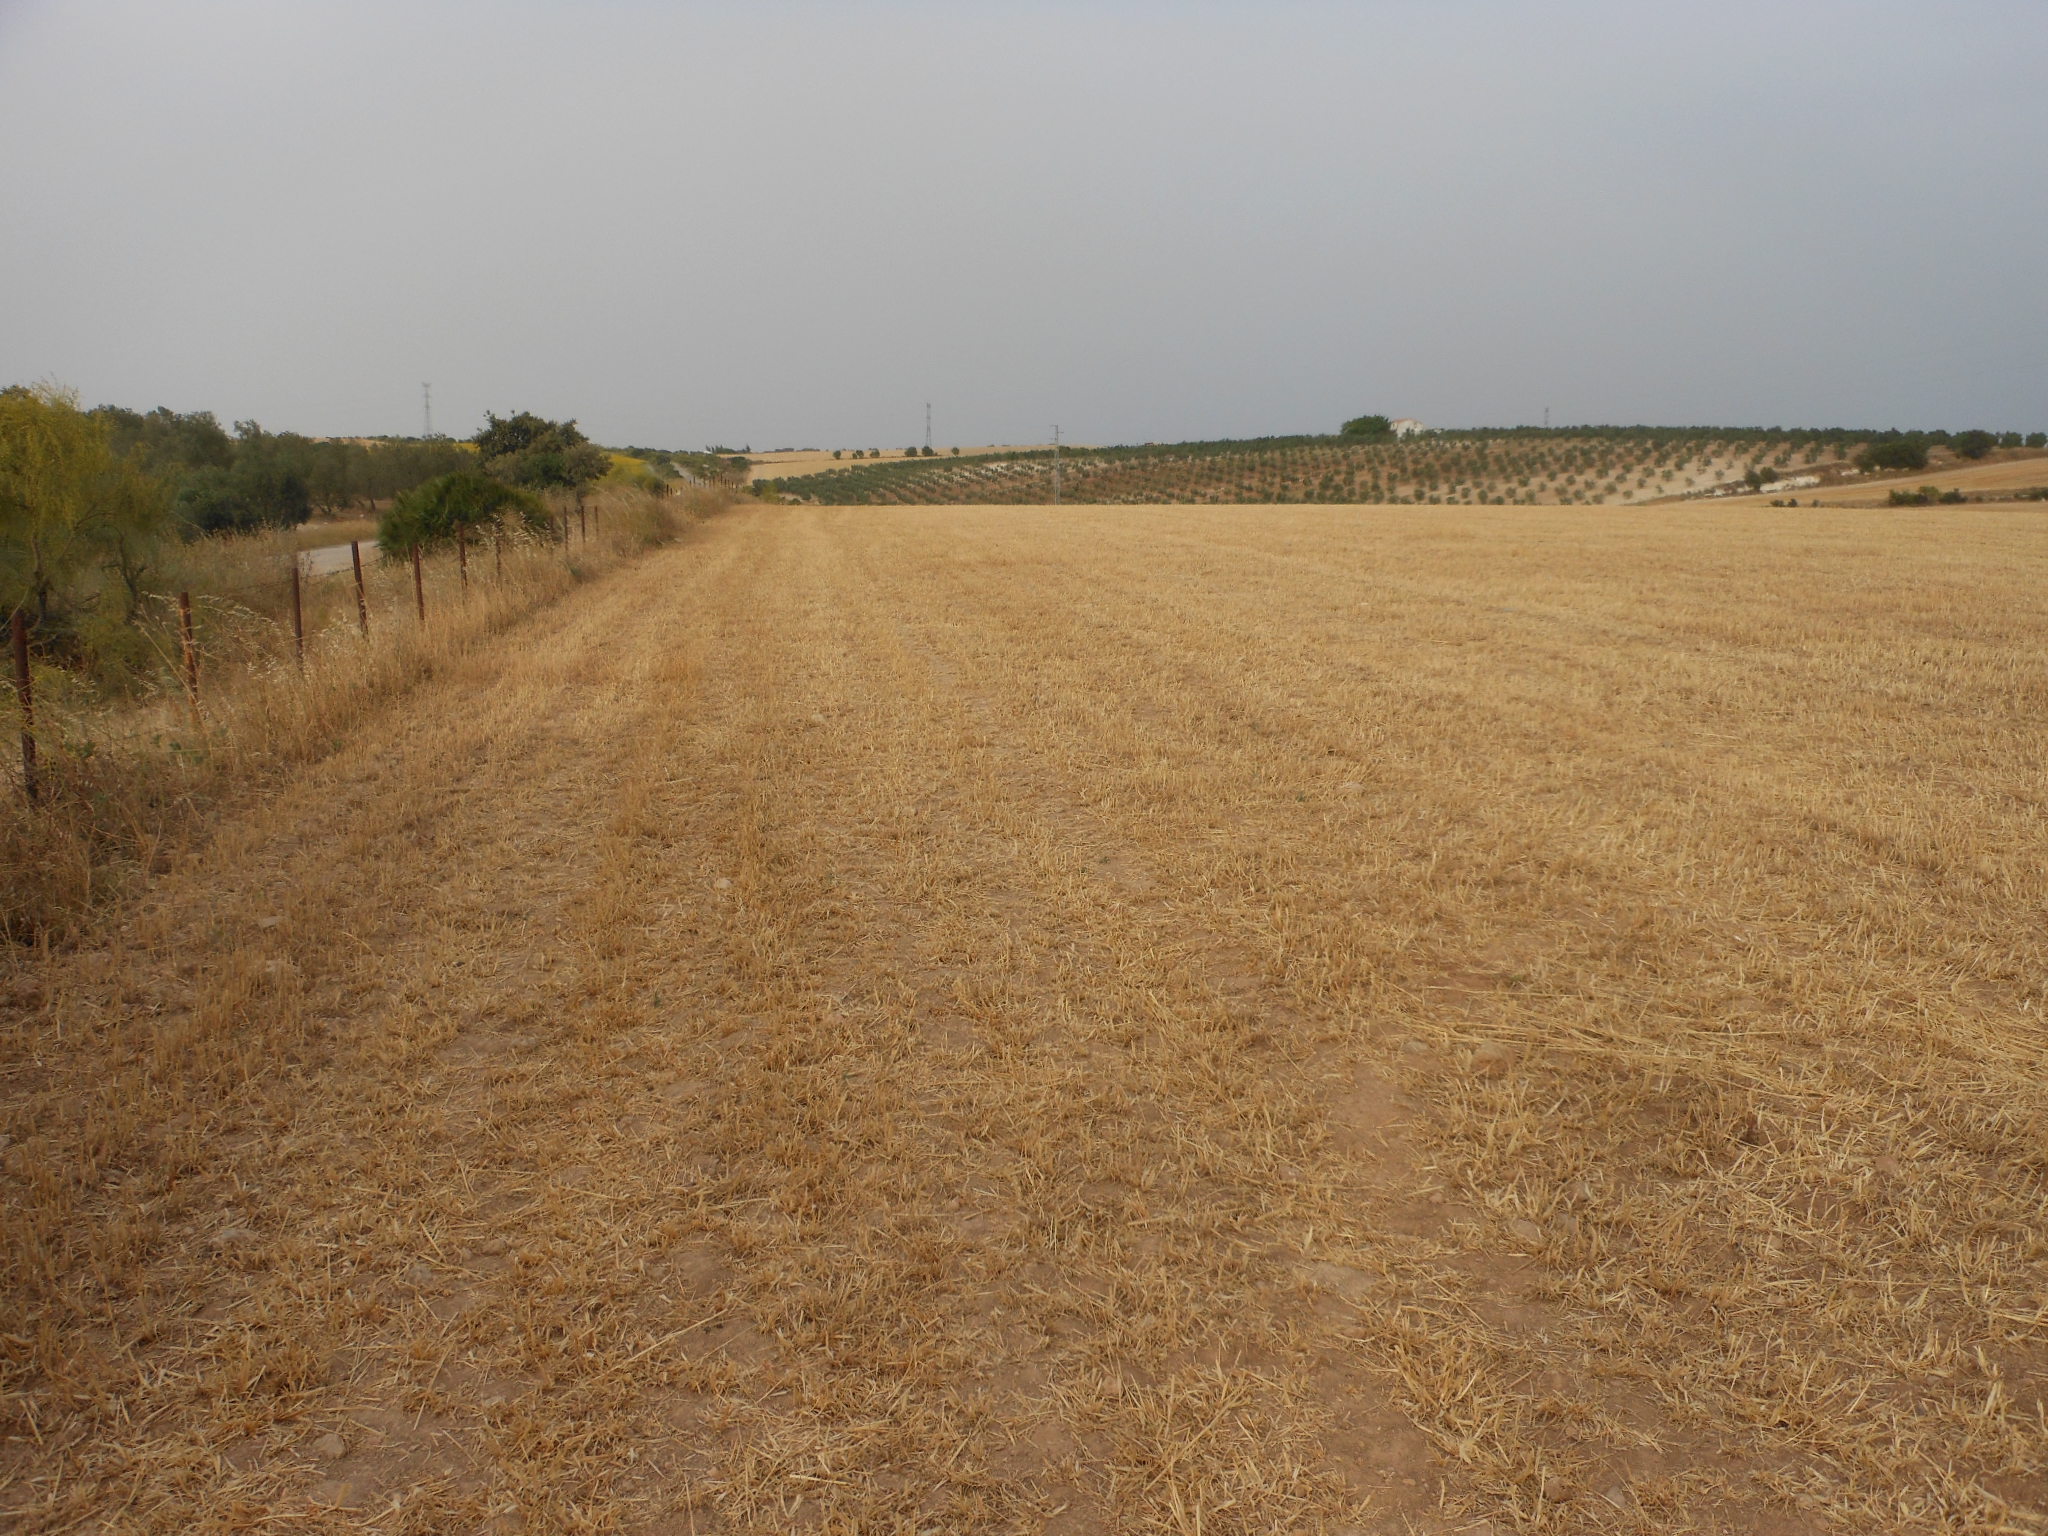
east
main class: Cropland
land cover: Oats
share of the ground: < 10 %
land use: Agriculture (excluding fallow land and kitchen gardens)
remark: Harvested field
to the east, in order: Oats
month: June
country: ES
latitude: 37.1265
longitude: -5.4189
